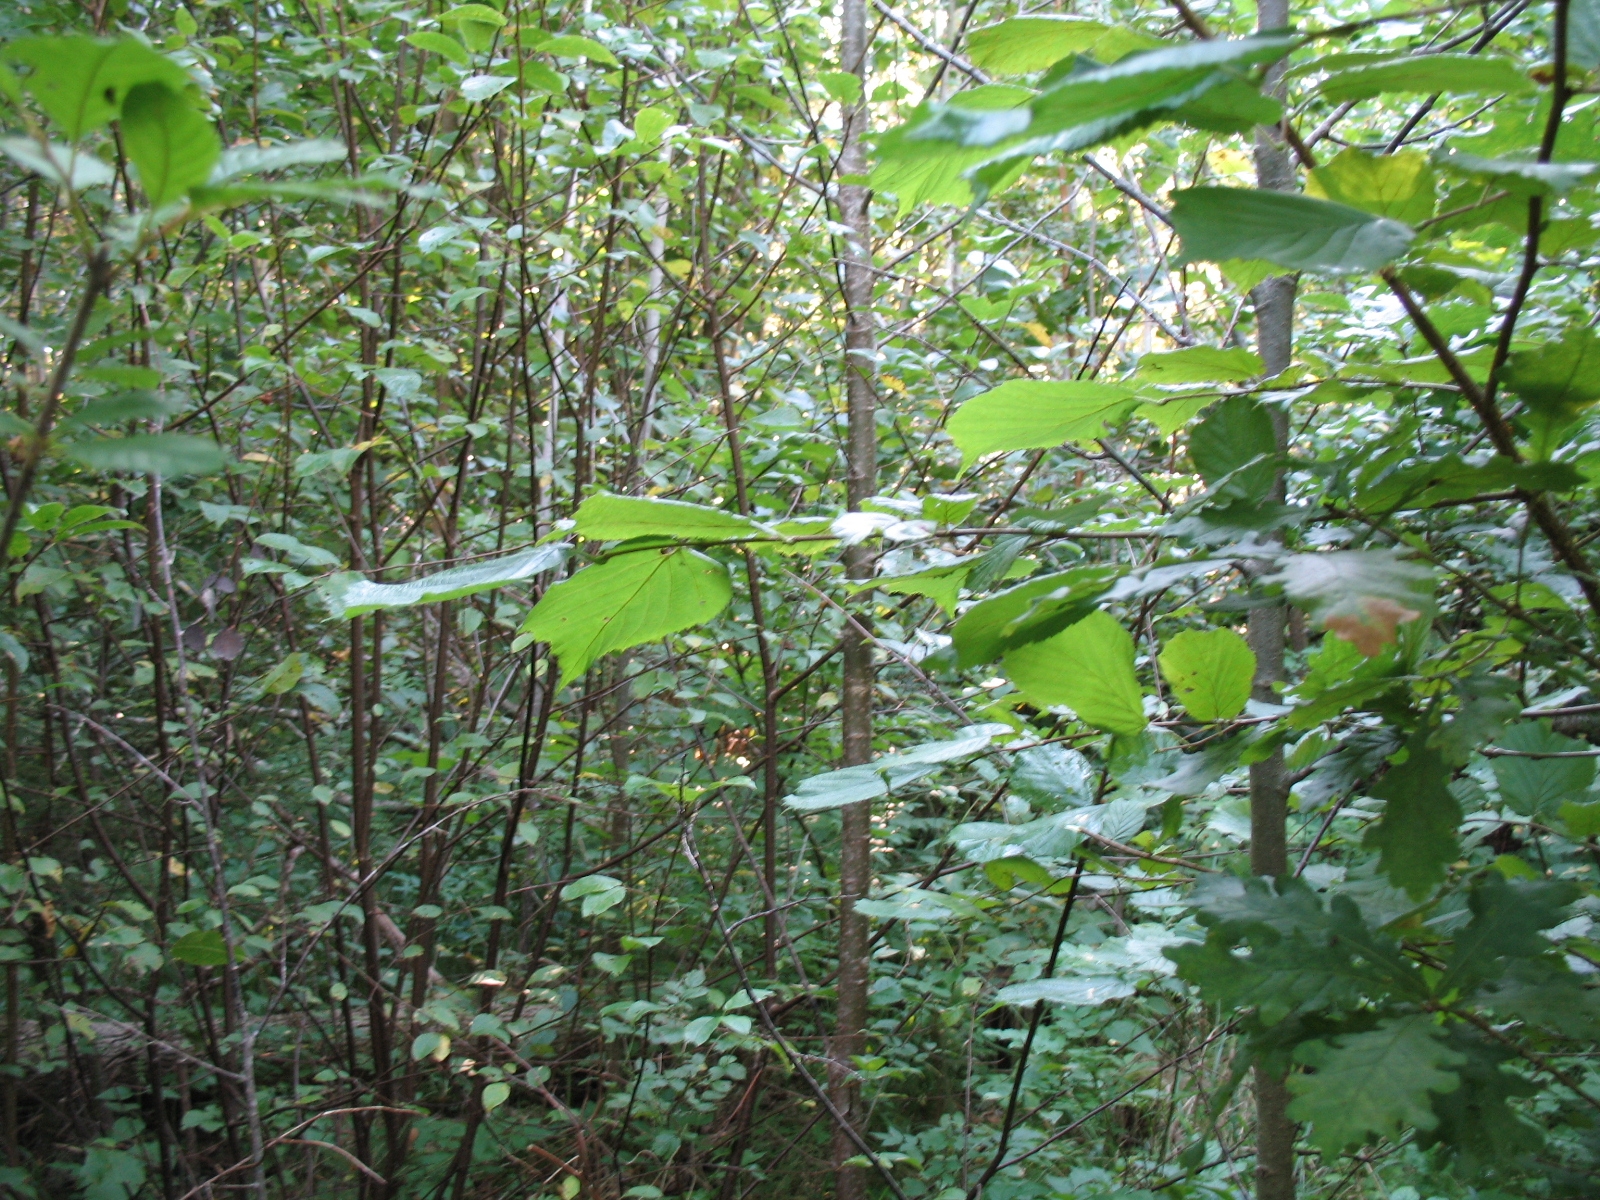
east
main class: Woodland
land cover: Broadleaved woodland
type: non-riverine alder, birch or aspen forest
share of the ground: > 75 %
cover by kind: broadleaved forest trees 90 %, shrubs 5 %, herbaceous plants 5 %
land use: Forestry
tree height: > 5 m
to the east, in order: Broadleaved woodland; Ditches and canals; Broadleaved woodland
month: August
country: LV
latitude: 56.6061
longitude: 25.7157
